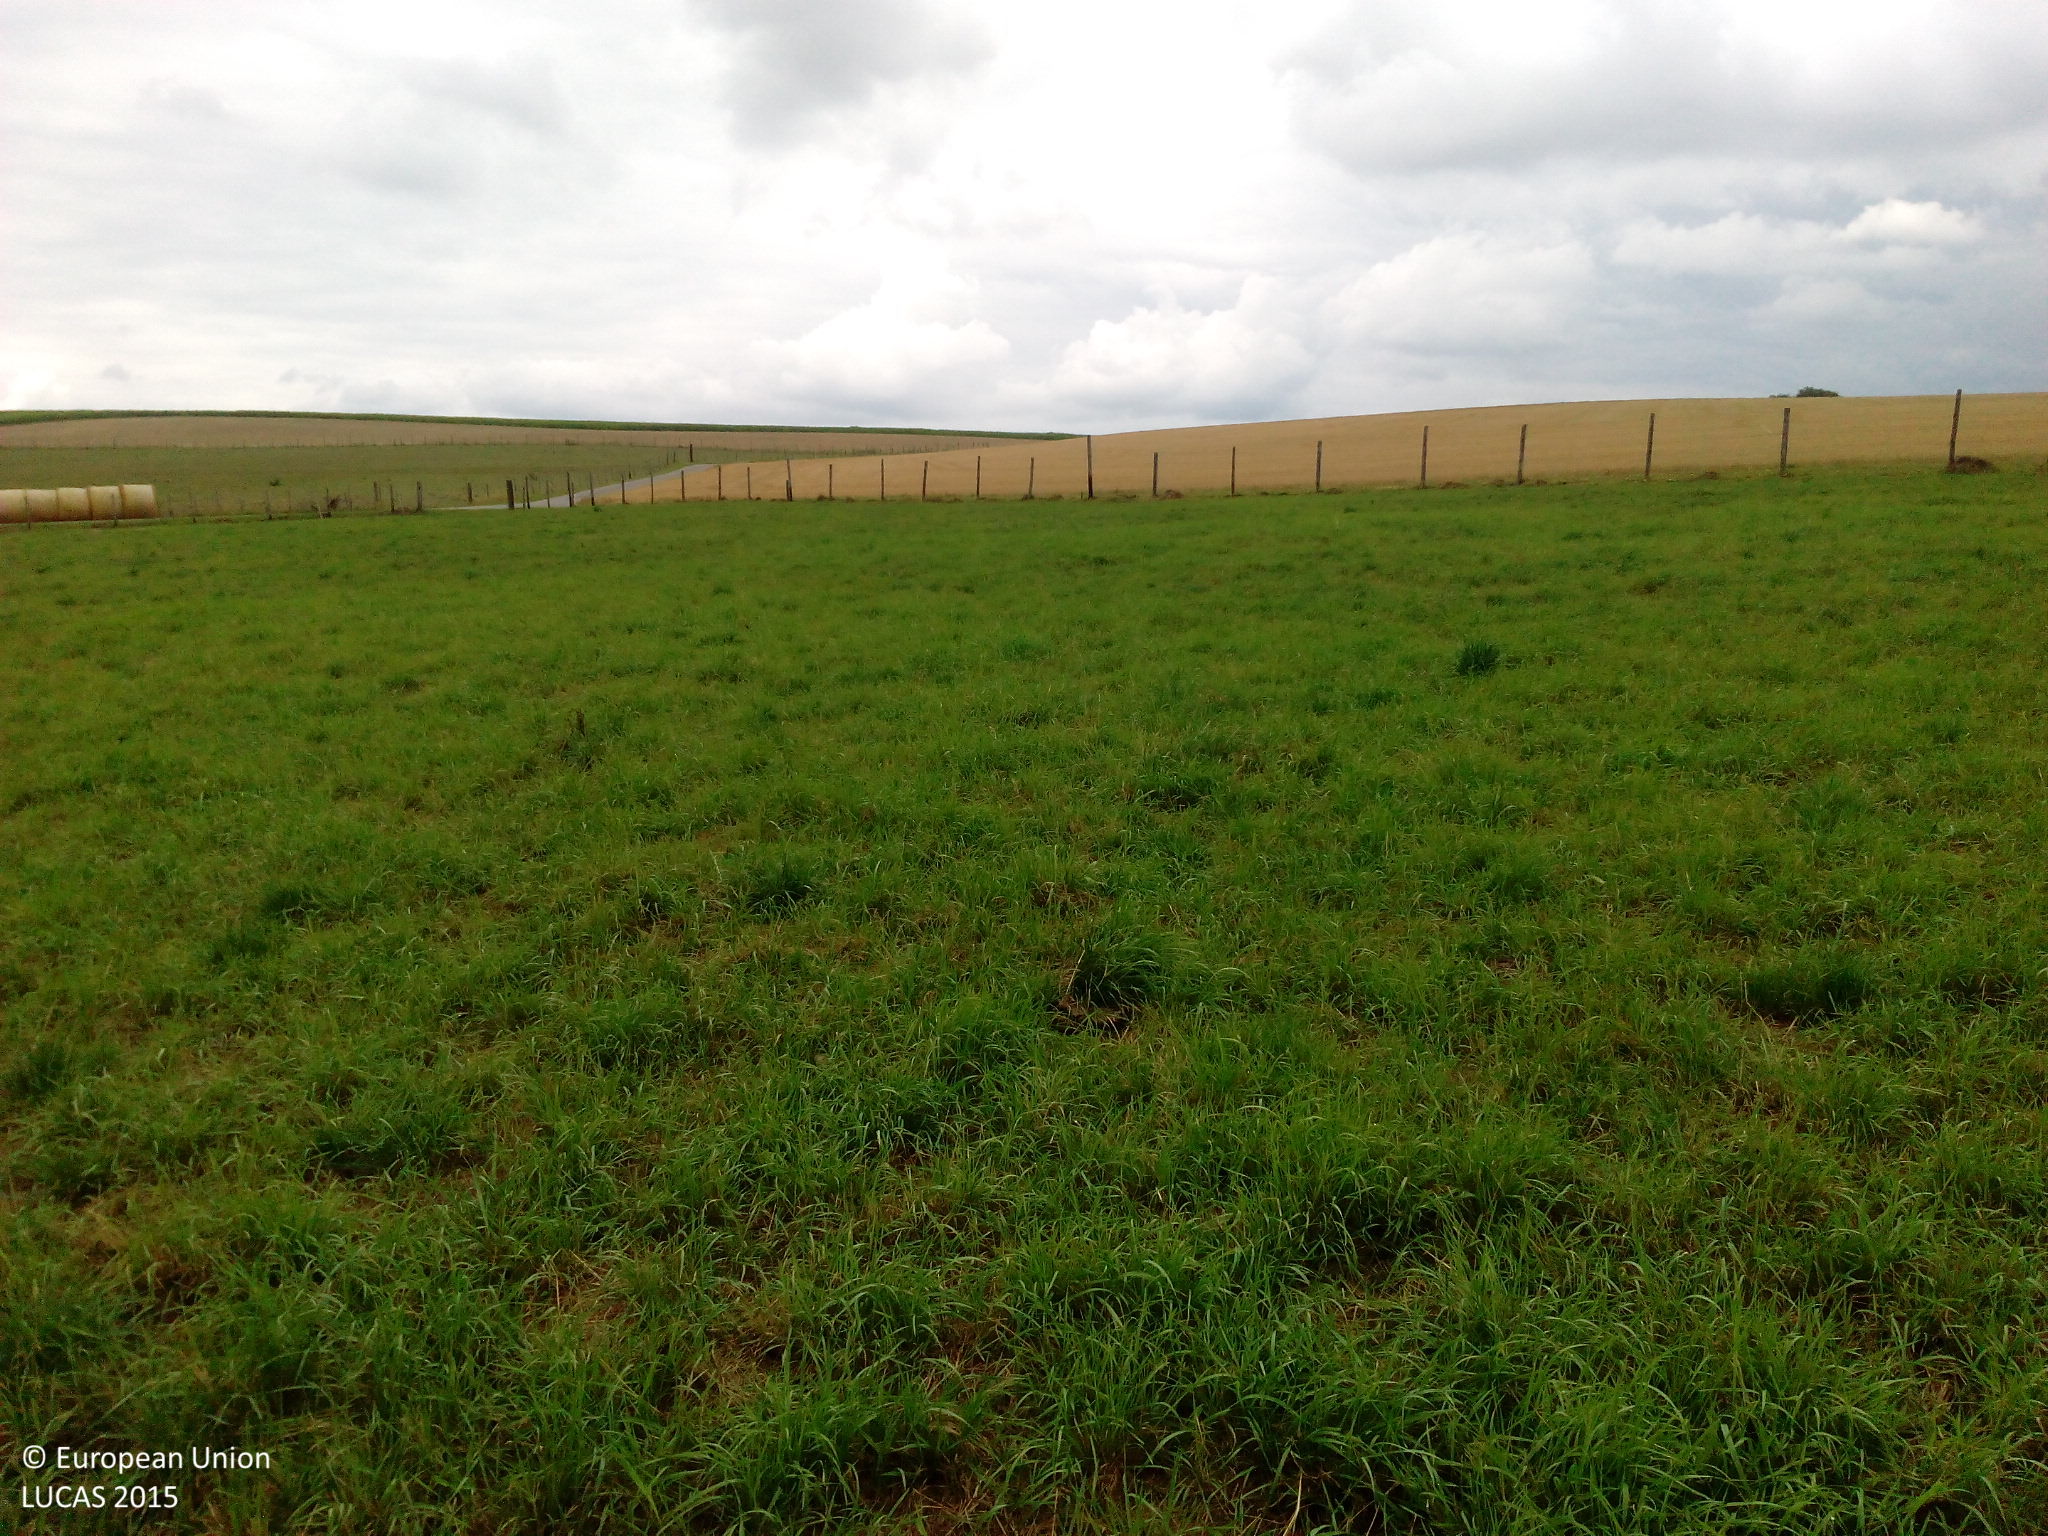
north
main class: Grassland
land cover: Grassland without tree/shrub cover
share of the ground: > 75 %
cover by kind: herbaceous plants 95 %, unconsolidated bare surface 5 %
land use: Agriculture (excluding fallow land and kitchen gardens)
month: August
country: DE
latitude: 50.0489
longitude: 7.5005
